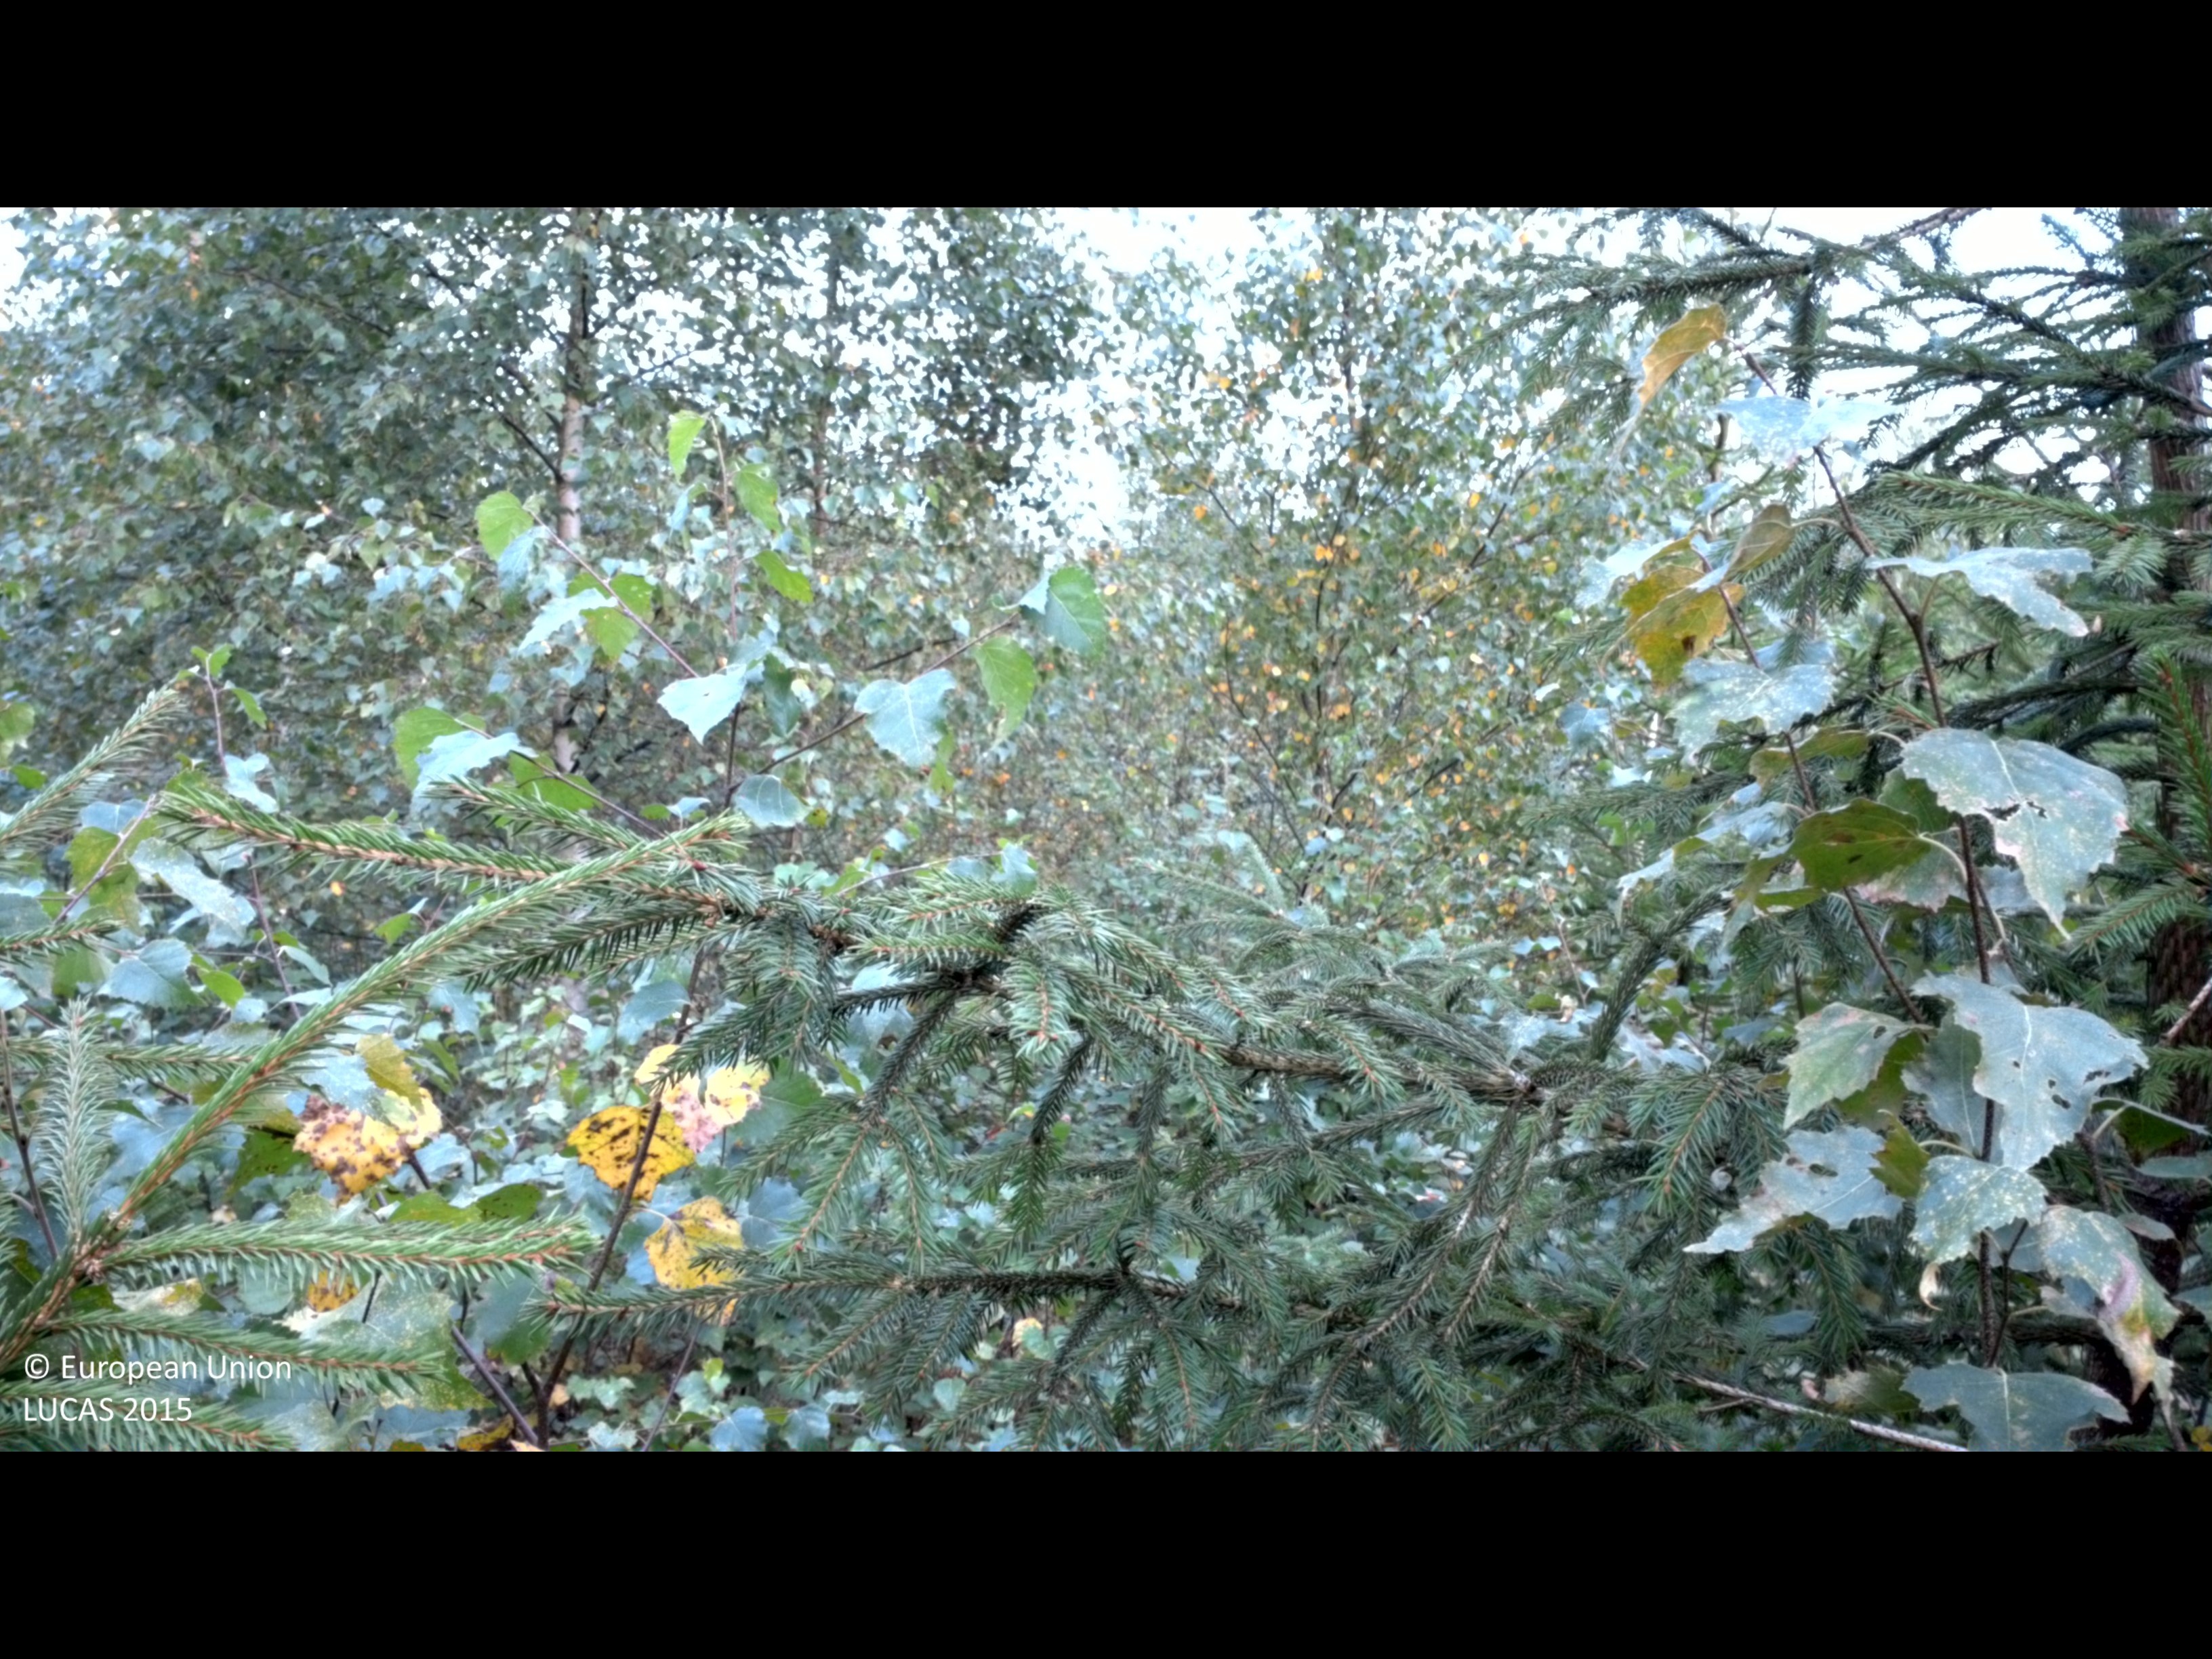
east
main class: Woodland
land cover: Spruce dominated mixed woodland
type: boreal forest
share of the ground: > 75 %
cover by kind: broadleaved forest trees 55 %, coniferous forest trees 35 %, shrubs 5 %, herbaceous plants 5 %
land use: Forestry
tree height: < 5 m
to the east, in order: Spruce dominated mixed woodland; Tracks; Spruce dominated mixed woodland; Rivers and streams; Spruce dominated mixed woodland; Spruce dominated coniferous woodland; Pine dominated mixed woodland; Spruce dominated mixed woodland; Tracks; Spruce dominated mixed woodland
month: September
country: SE
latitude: 56.7616
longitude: 13.1211
